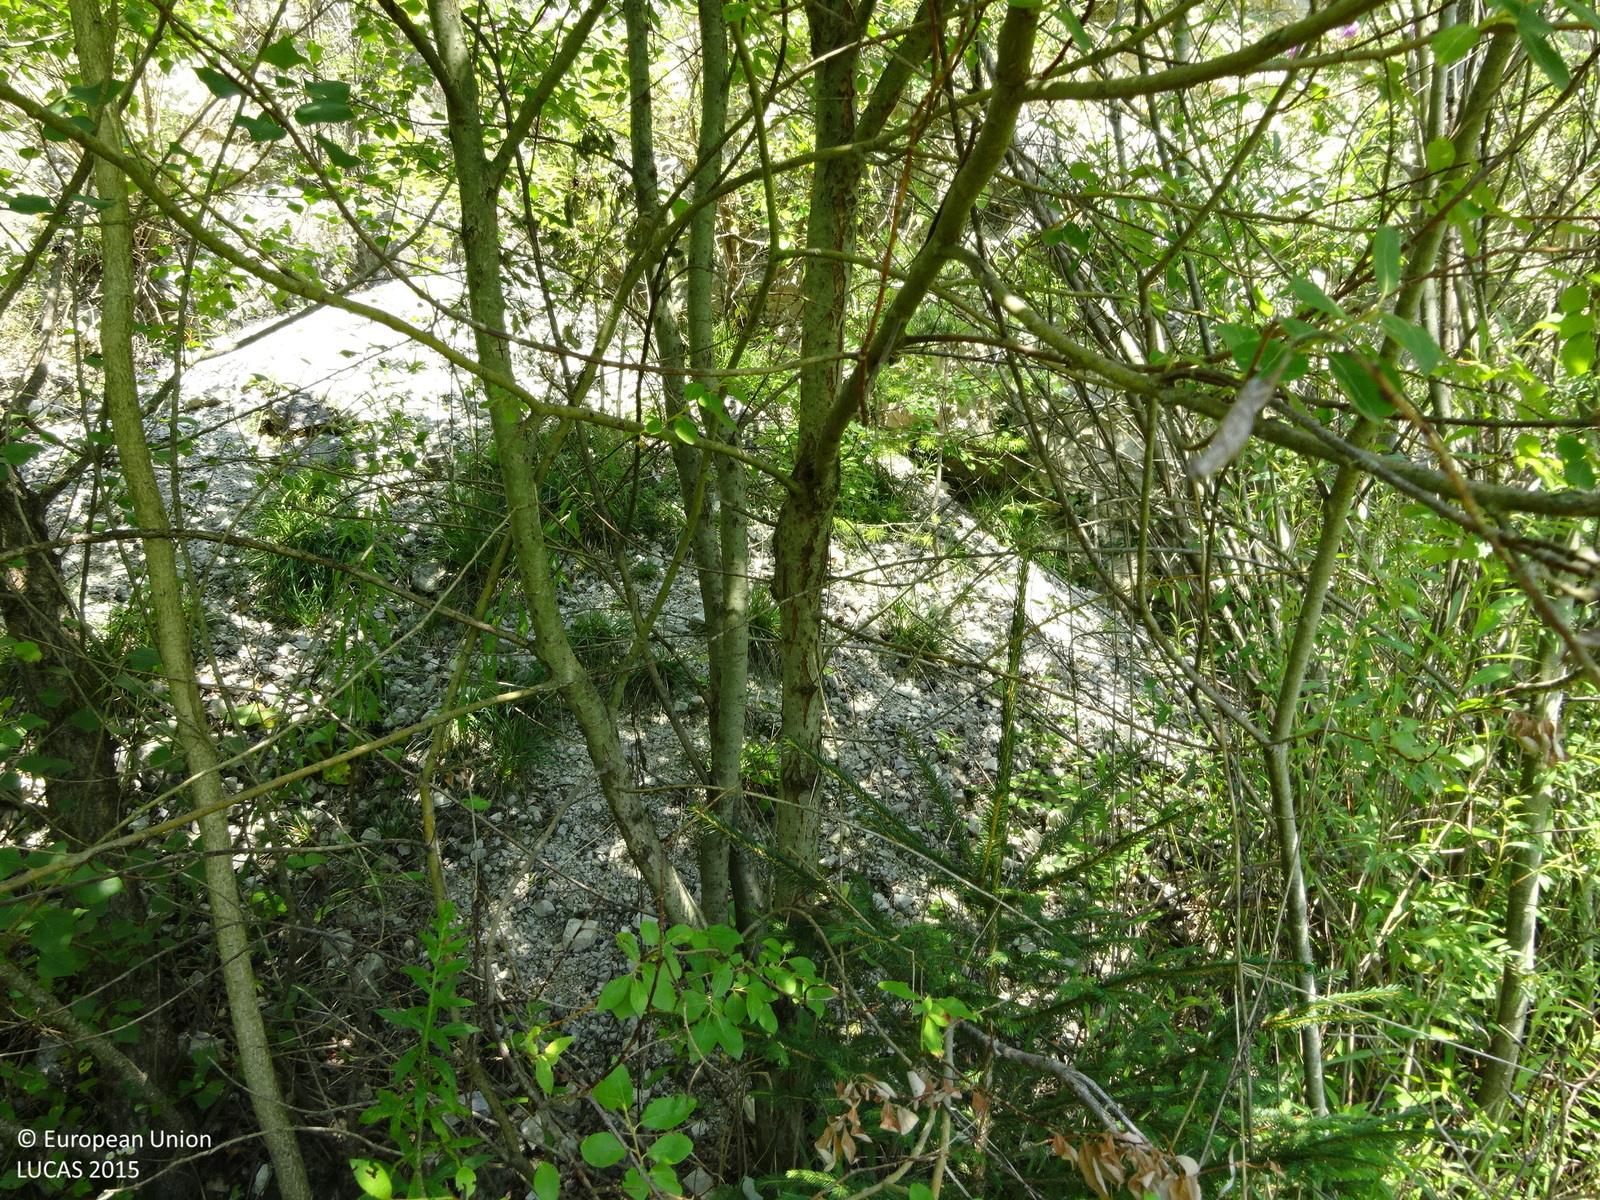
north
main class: Shrubland
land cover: Shrubland with sparse tree cover
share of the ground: 50 - 75 %
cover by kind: shrubs 75 %, herbaceous plants 20 %, coniferous forest trees 5 %
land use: Abandoned areas
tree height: > 5 m
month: July
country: AT
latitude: 47.1741
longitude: 15.3435
